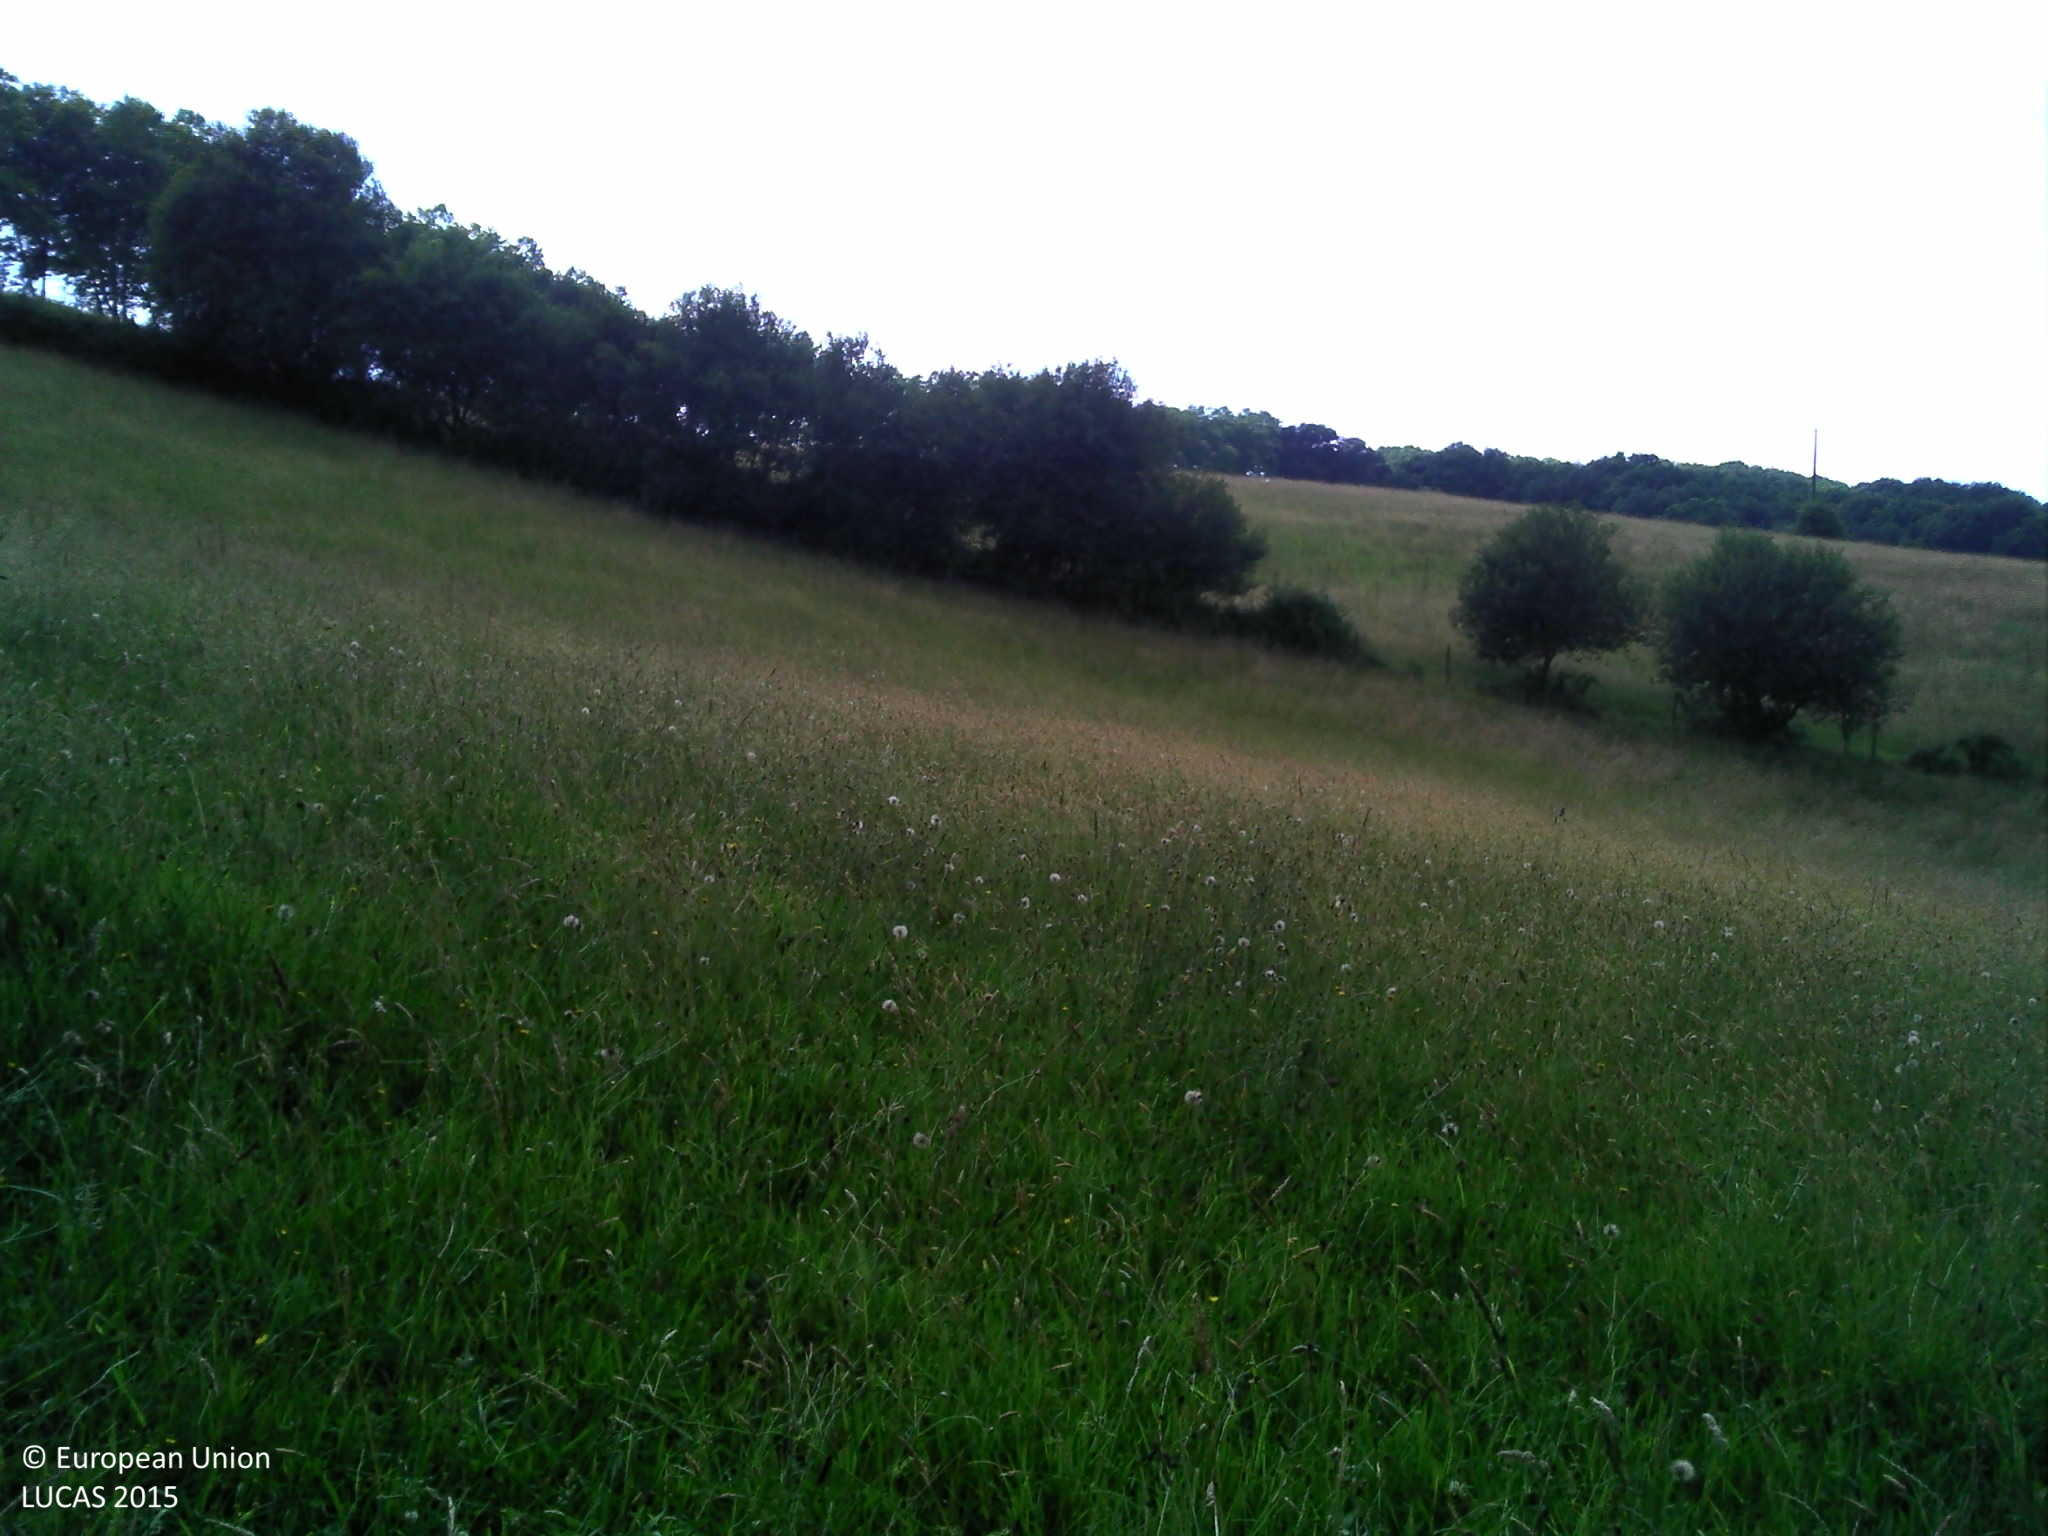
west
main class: Grassland
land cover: Grassland without tree/shrub cover
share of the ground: > 75 %
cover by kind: herbaceous plants 100 %
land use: Agriculture (excluding fallow land and kitchen gardens)
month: June
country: FR
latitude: 43.3024
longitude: -0.7222
